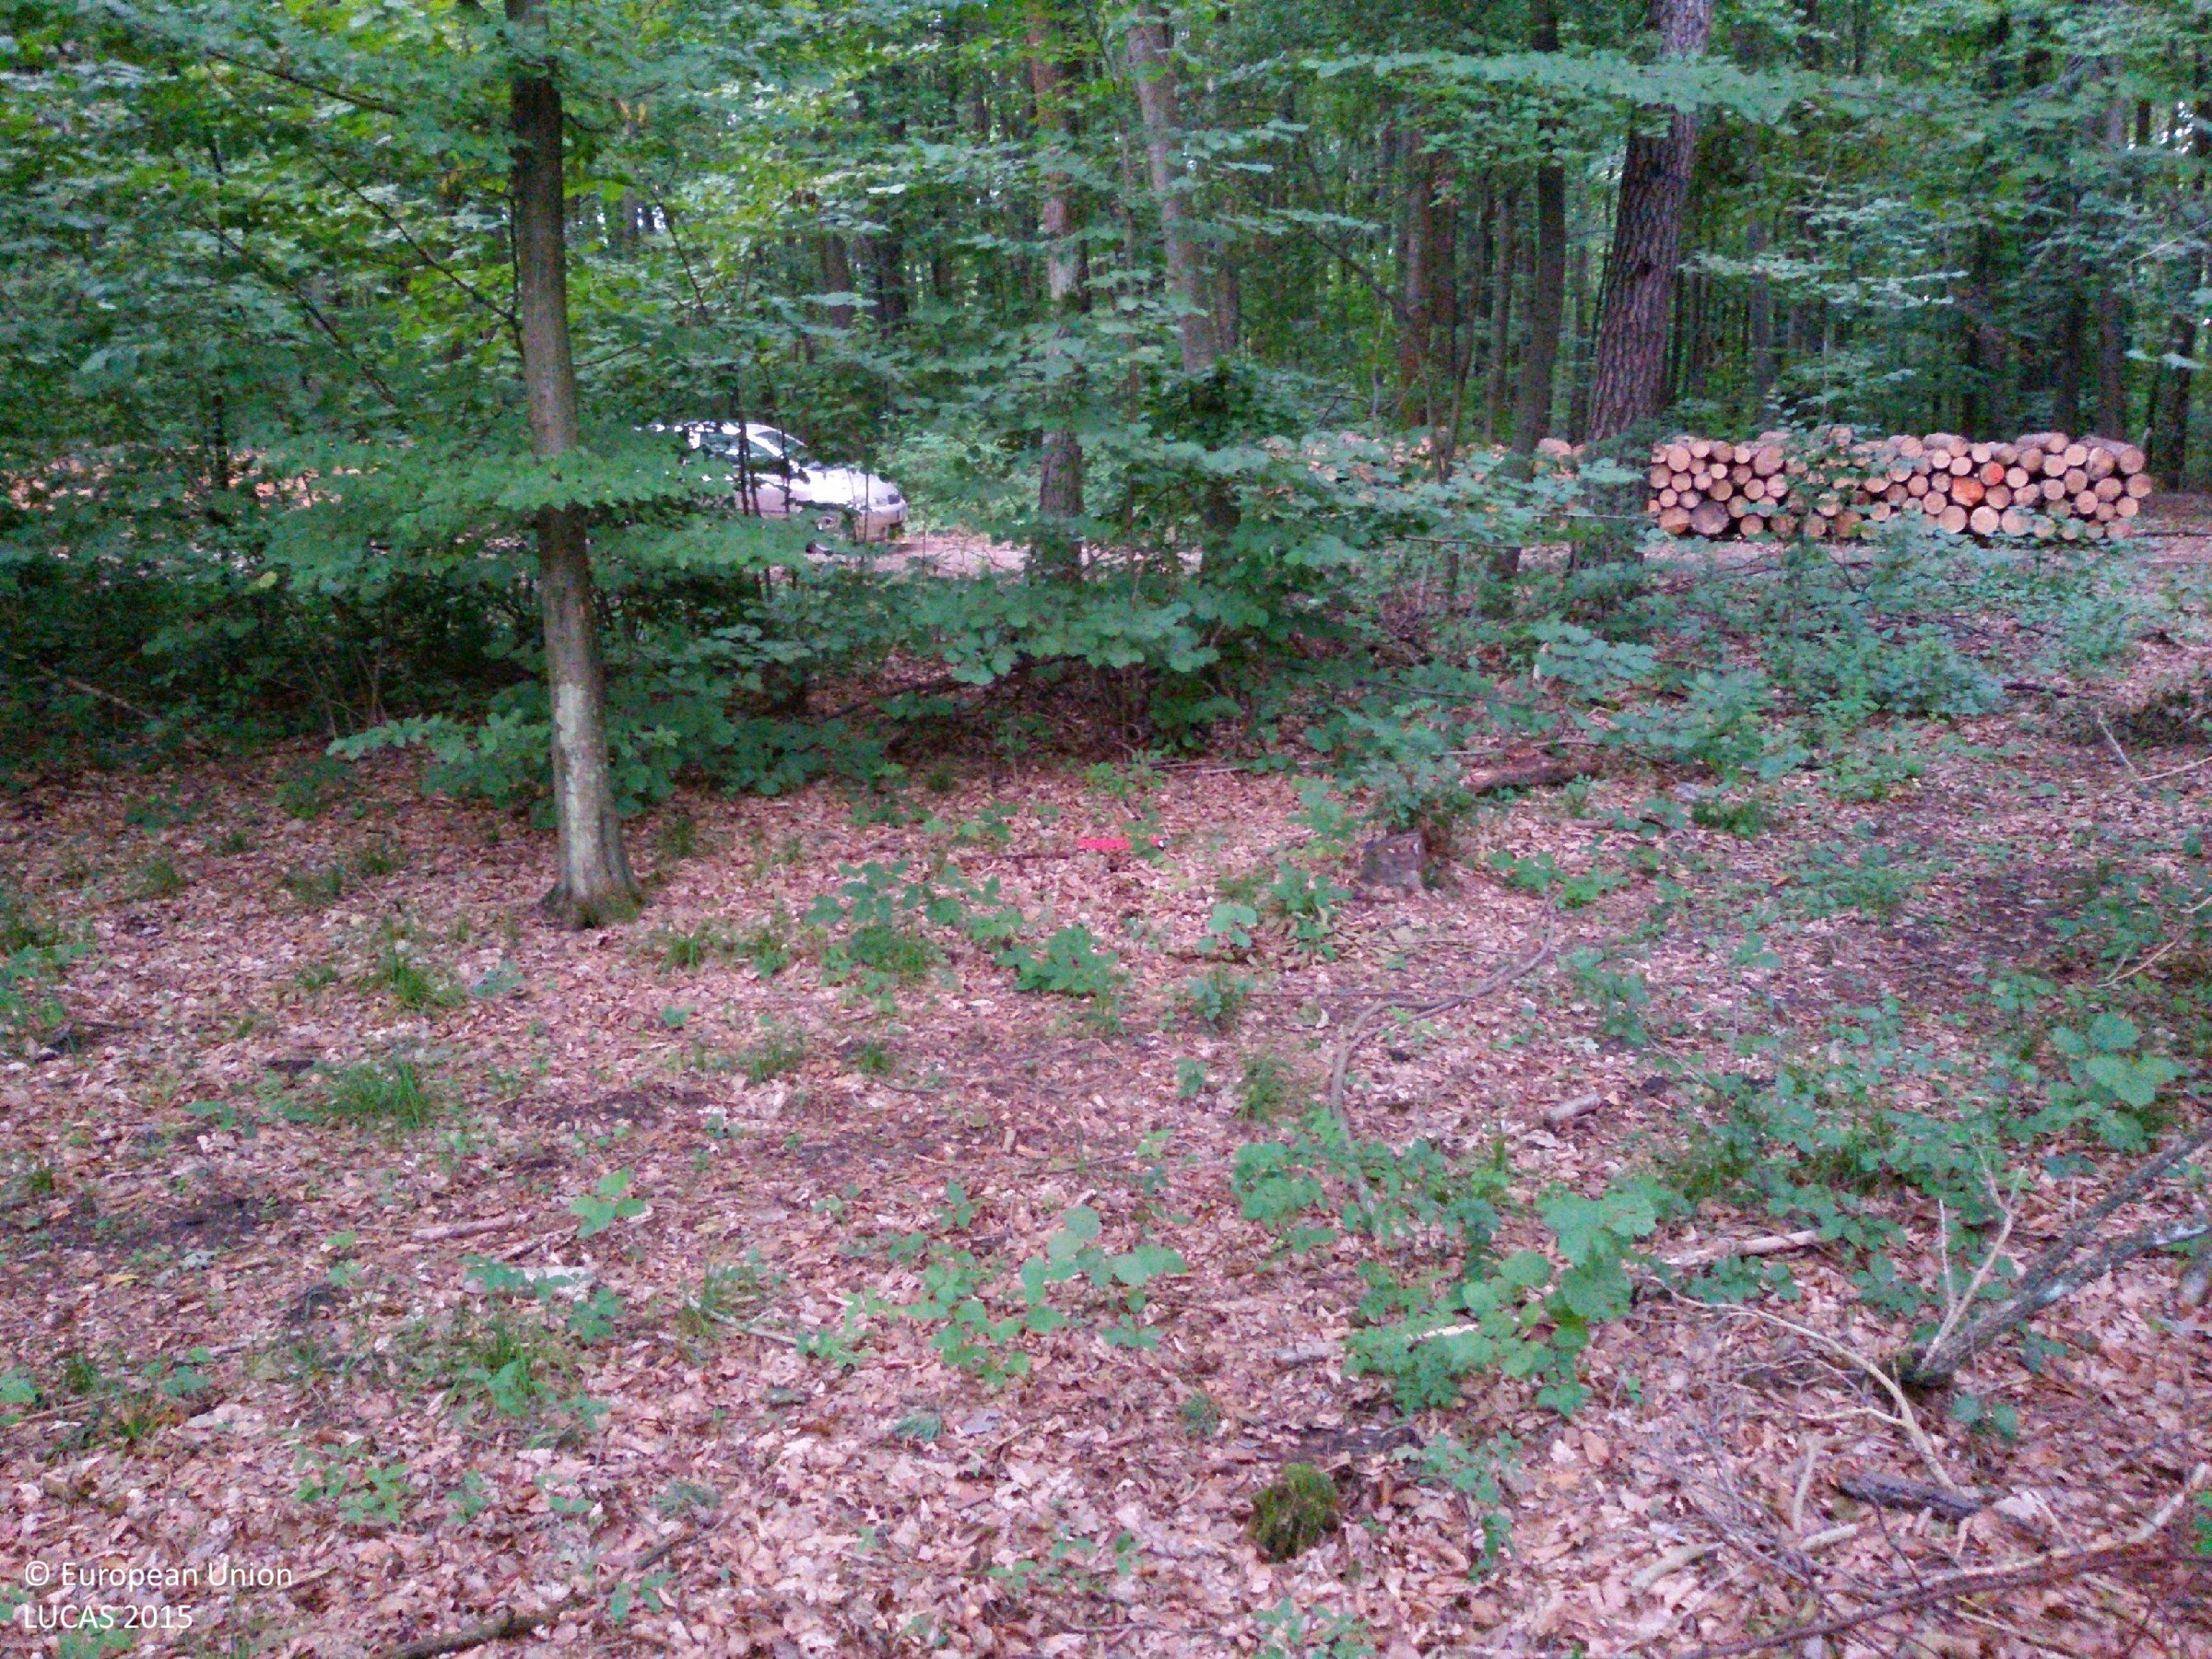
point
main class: Woodland
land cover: Broadleaved woodland
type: mesophytic deciduous forest
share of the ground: > 75 %
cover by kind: broadleaved forest trees 90 %, coniferous forest trees 5 %, herbaceous plants 5 %
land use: Forestry
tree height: > 5 m
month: July
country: PL
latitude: 50.5947
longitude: 21.3644
